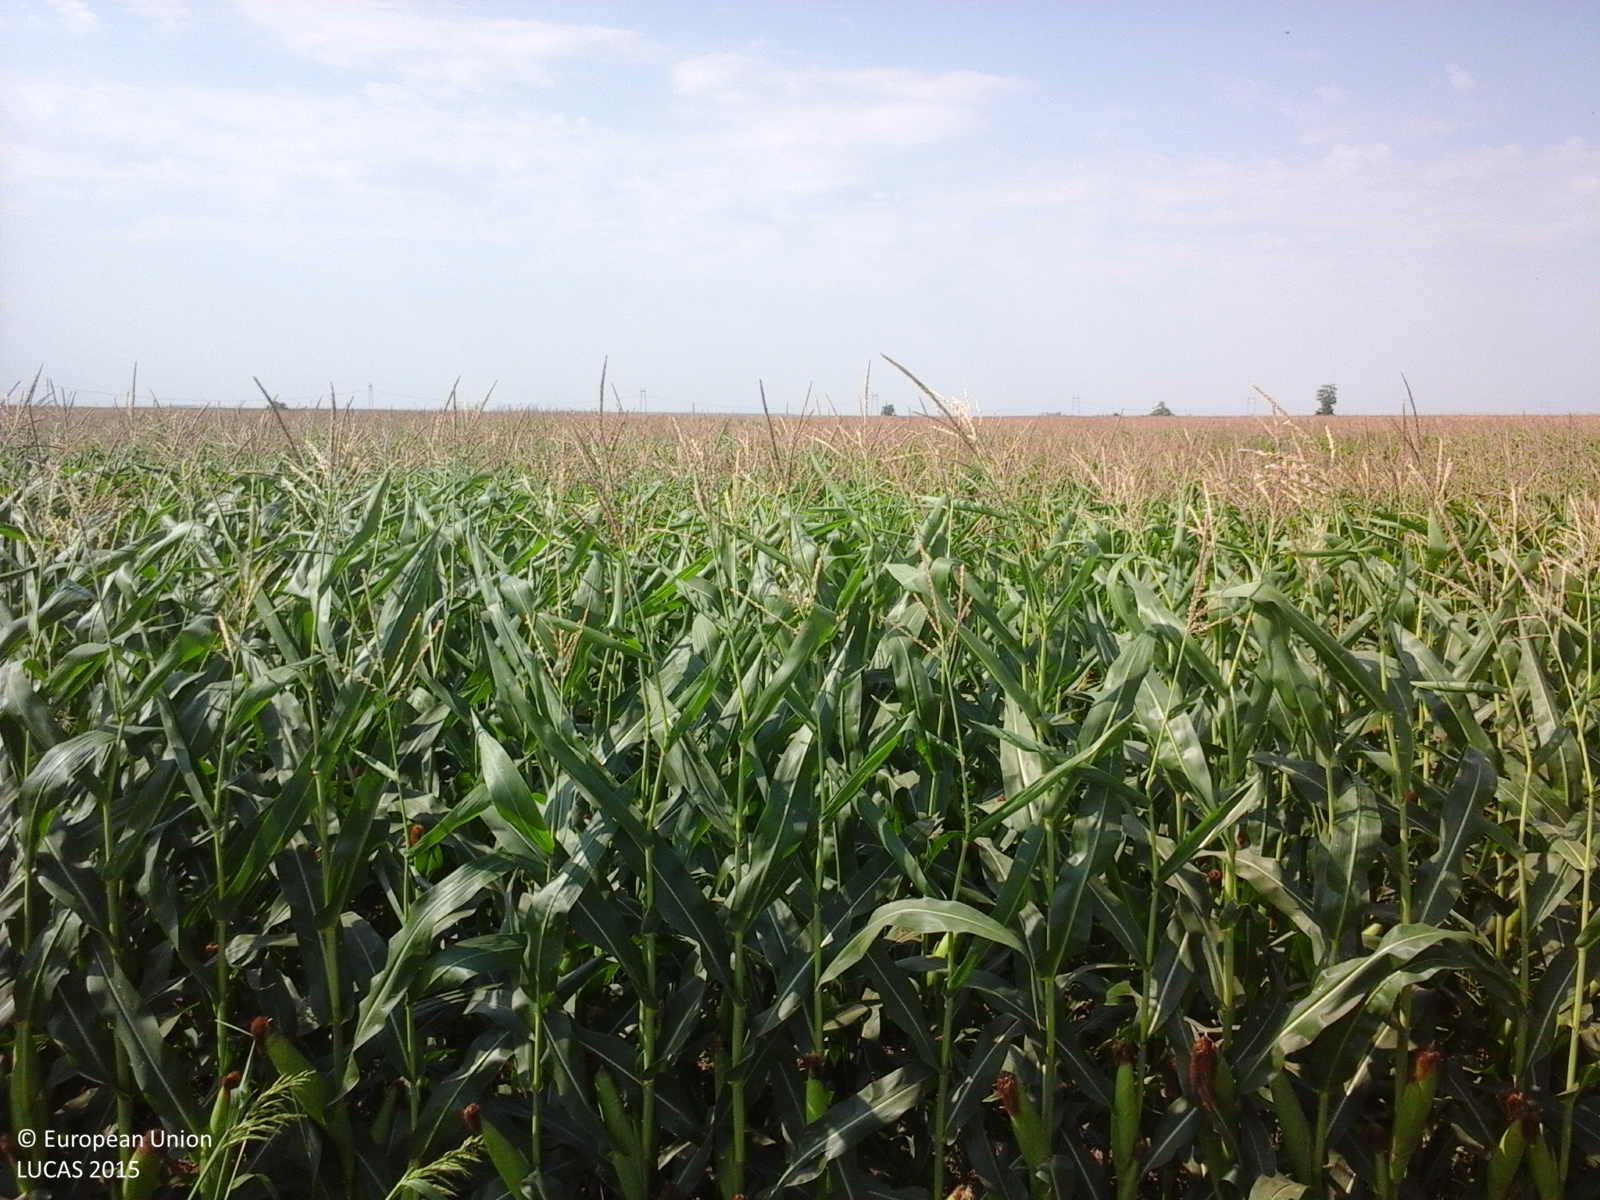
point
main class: Cropland
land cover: Maize
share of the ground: > 75 %
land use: Agriculture (excluding fallow land and kitchen gardens)
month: July
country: RO
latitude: 44.6464
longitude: 27.2212
